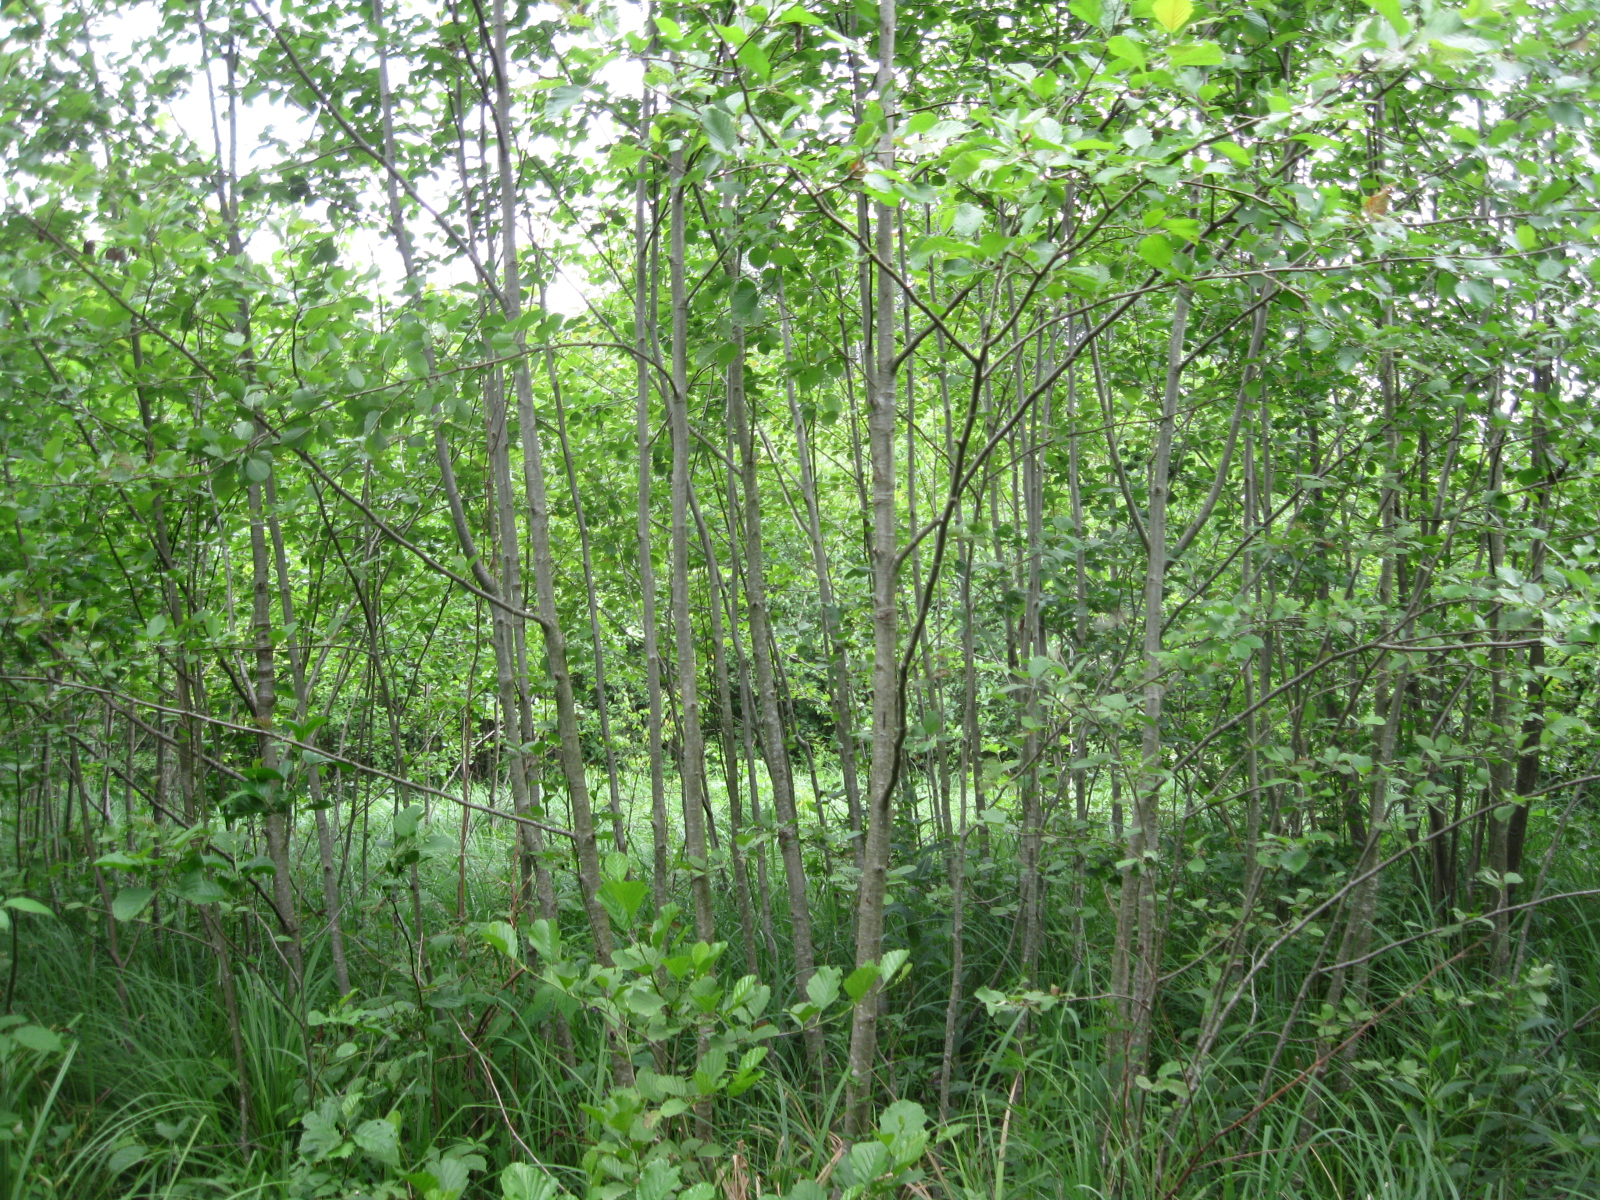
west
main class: Woodland
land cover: Broadleaved woodland
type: non-riverine alder, birch or aspen forest
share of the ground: > 75 %
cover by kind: broadleaved forest trees 80 %, herbaceous plants 15 %, shrubs 5 %
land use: Forestry
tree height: < 5 m
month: June
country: LT
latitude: 55.1016
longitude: 24.0240
